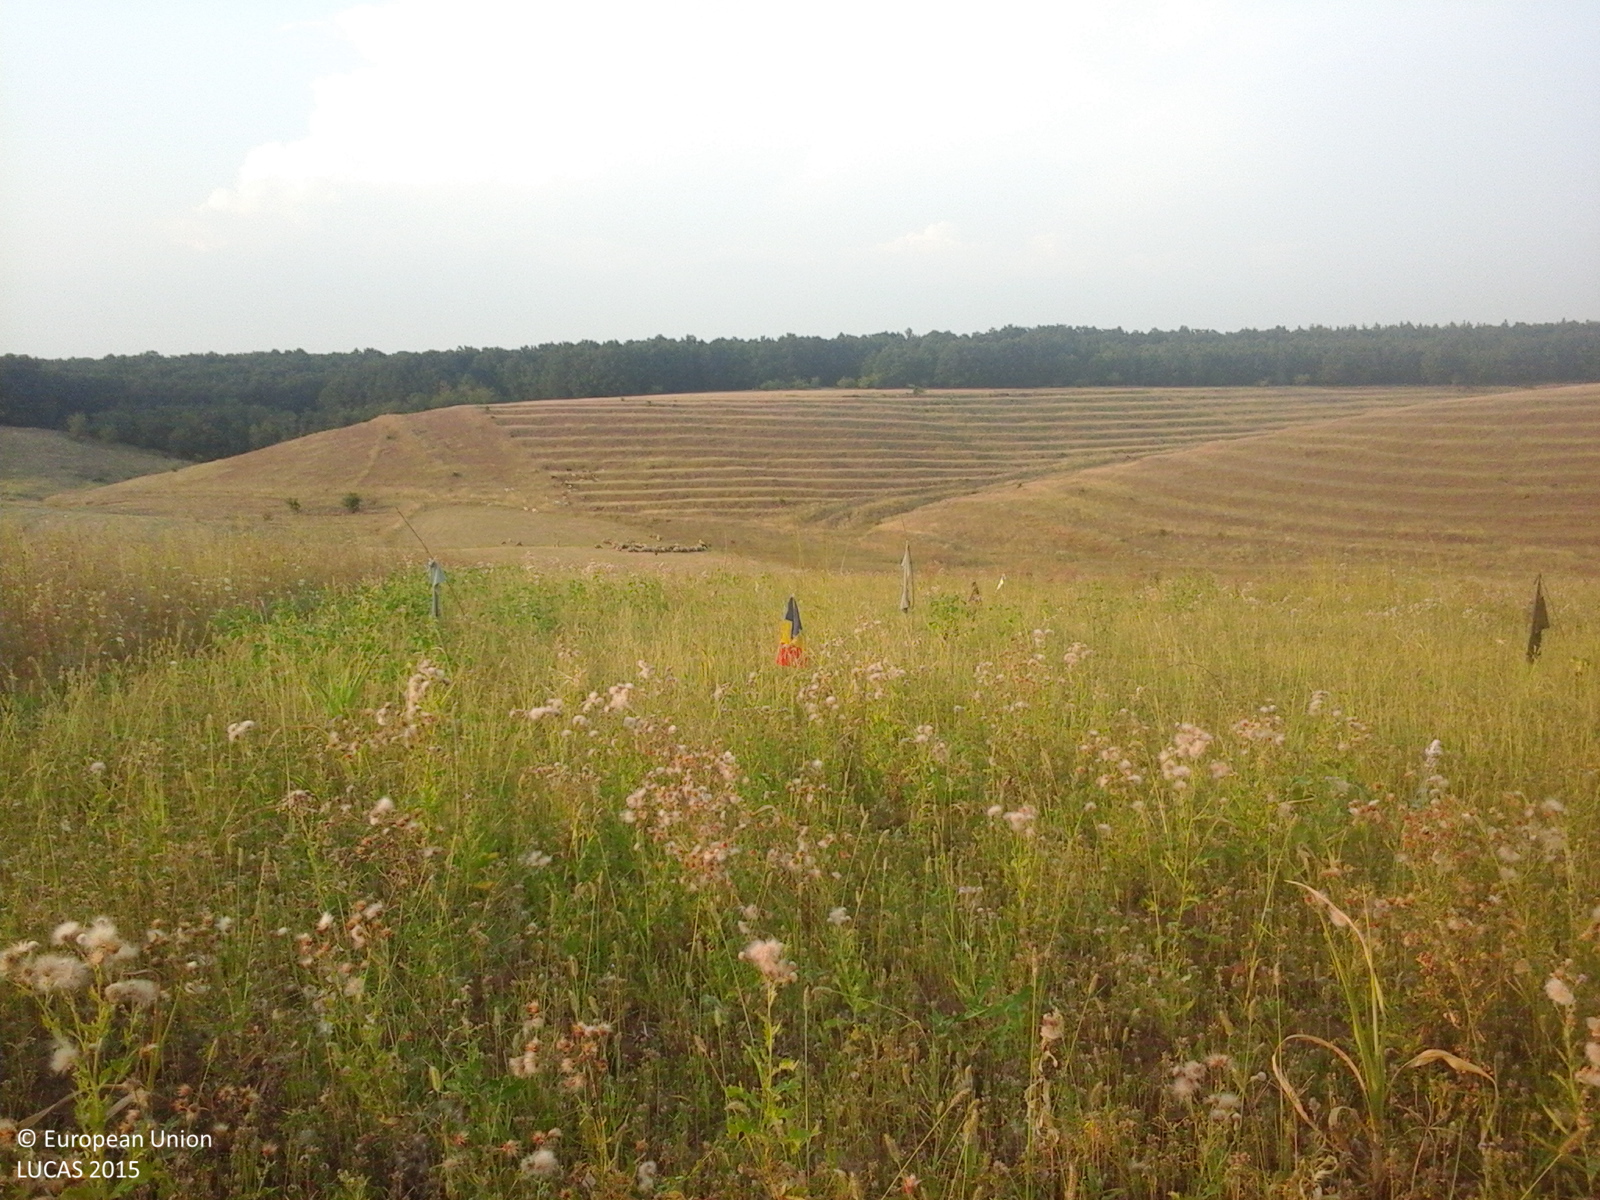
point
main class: Grassland
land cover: Spontaneously vegetated surfaces
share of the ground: > 75 %
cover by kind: herbaceous plants 100 %
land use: Fallow land
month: August
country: RO
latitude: 44.2311
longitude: 23.6370
